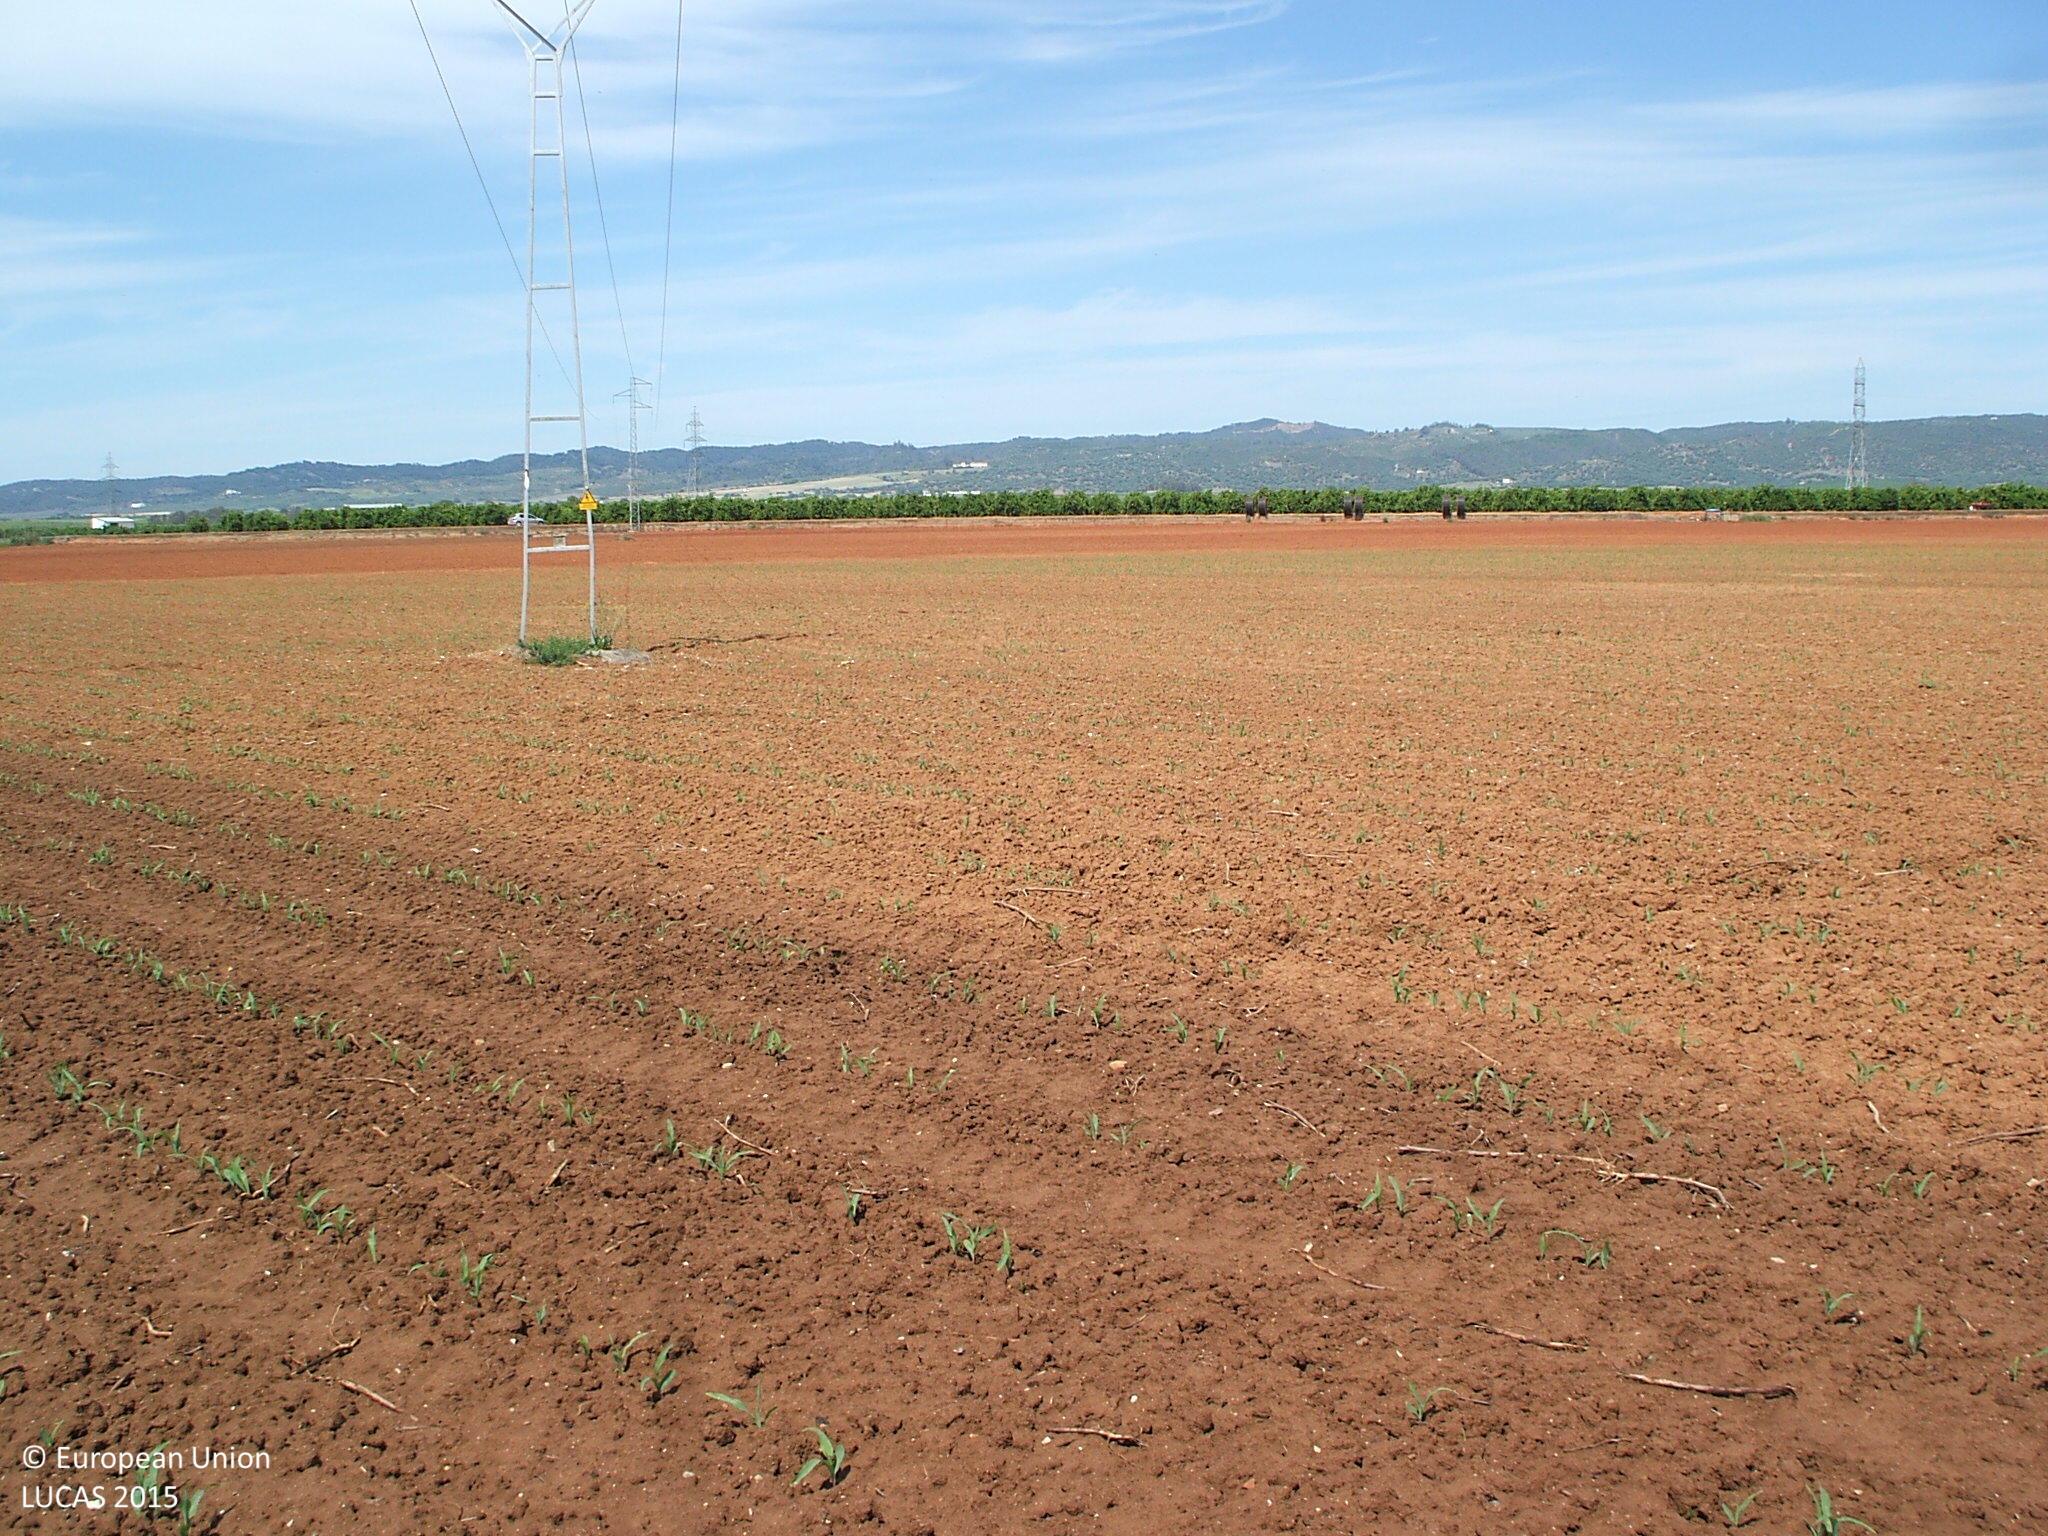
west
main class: Artificial land
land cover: Other artificial areas
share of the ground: < 10 %
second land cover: Maize
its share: < 10 %
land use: Electricity, gas and thermal power distribution
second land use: Agriculture (excluding fallow land and kitchen gardens)
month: April
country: ES
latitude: 37.6913
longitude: -5.4552
